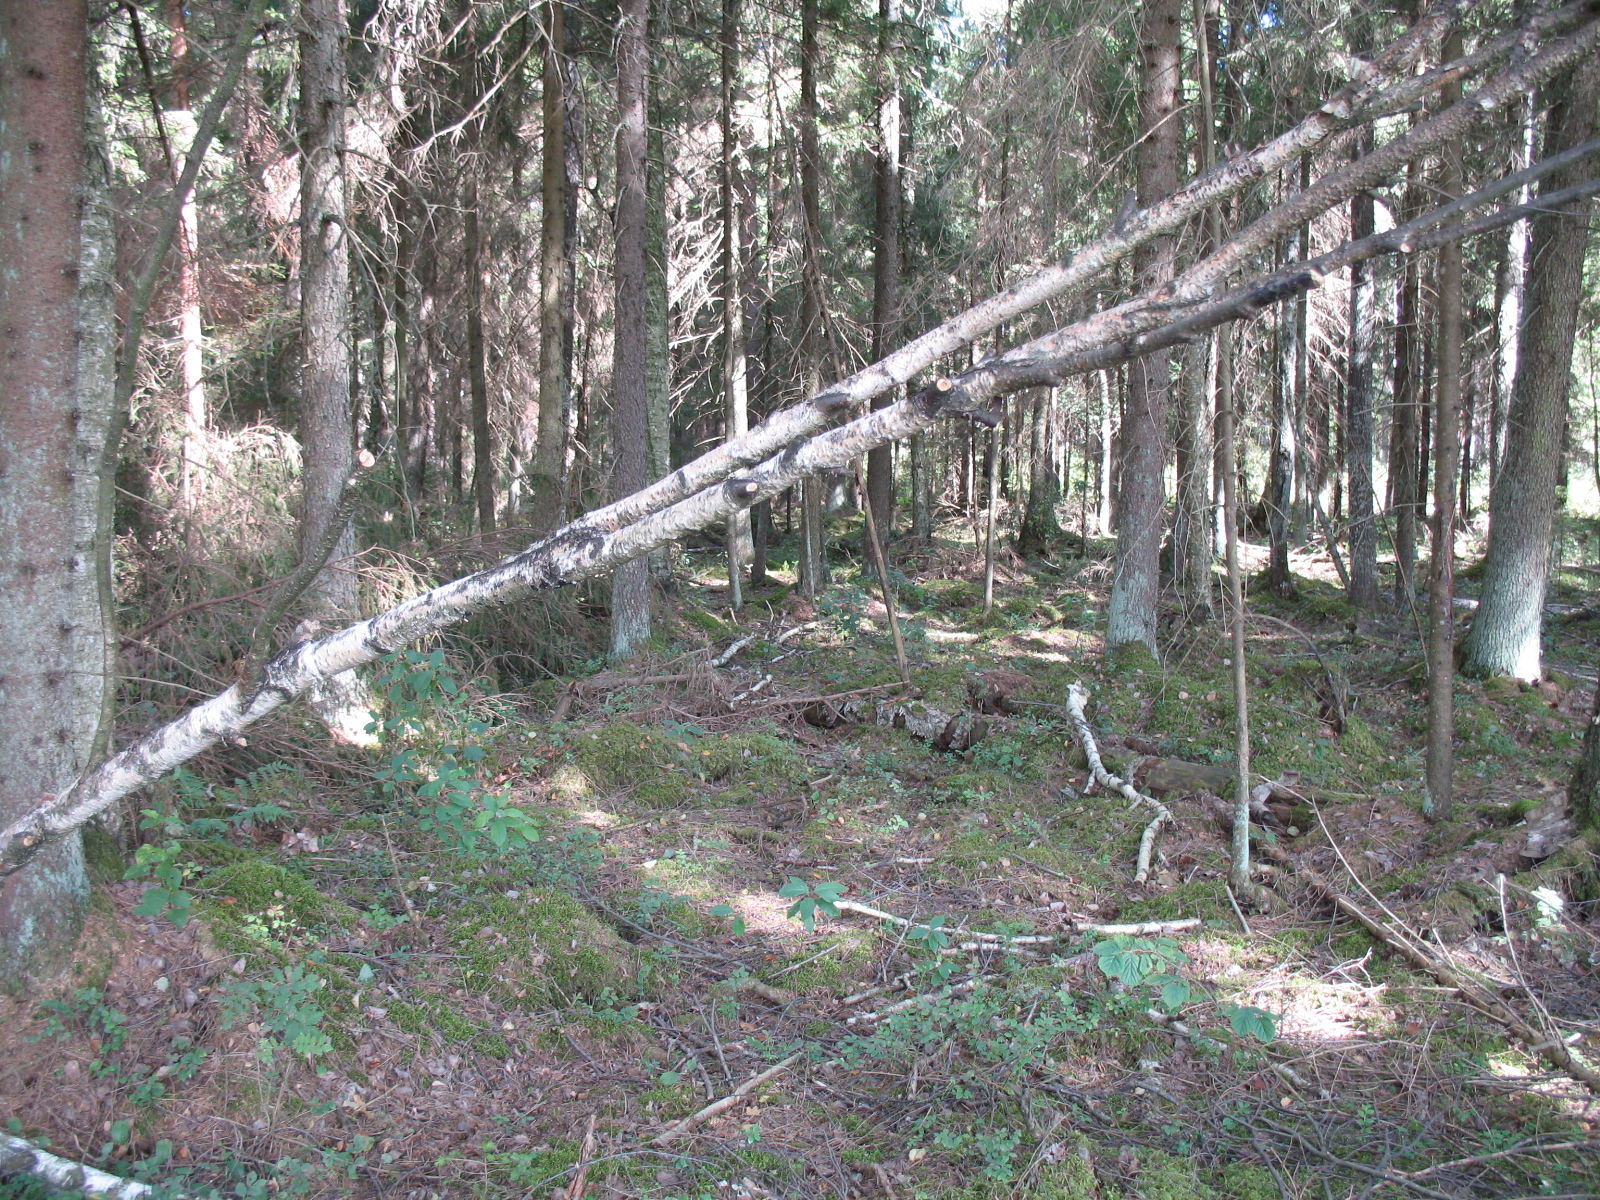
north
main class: Woodland
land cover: Other mixed woodland
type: hemiboreal forest and nemoral coniferous forest and mixed broadleaved-coniferous forest
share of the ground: > 75 %
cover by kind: coniferous forest trees 50 %, broadleaved forest trees 30 %, lichens and mosses 15 %, shrubs 5 %
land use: Forestry
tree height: > 5 m
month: August
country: LV
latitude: 56.4488
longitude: 25.6502
